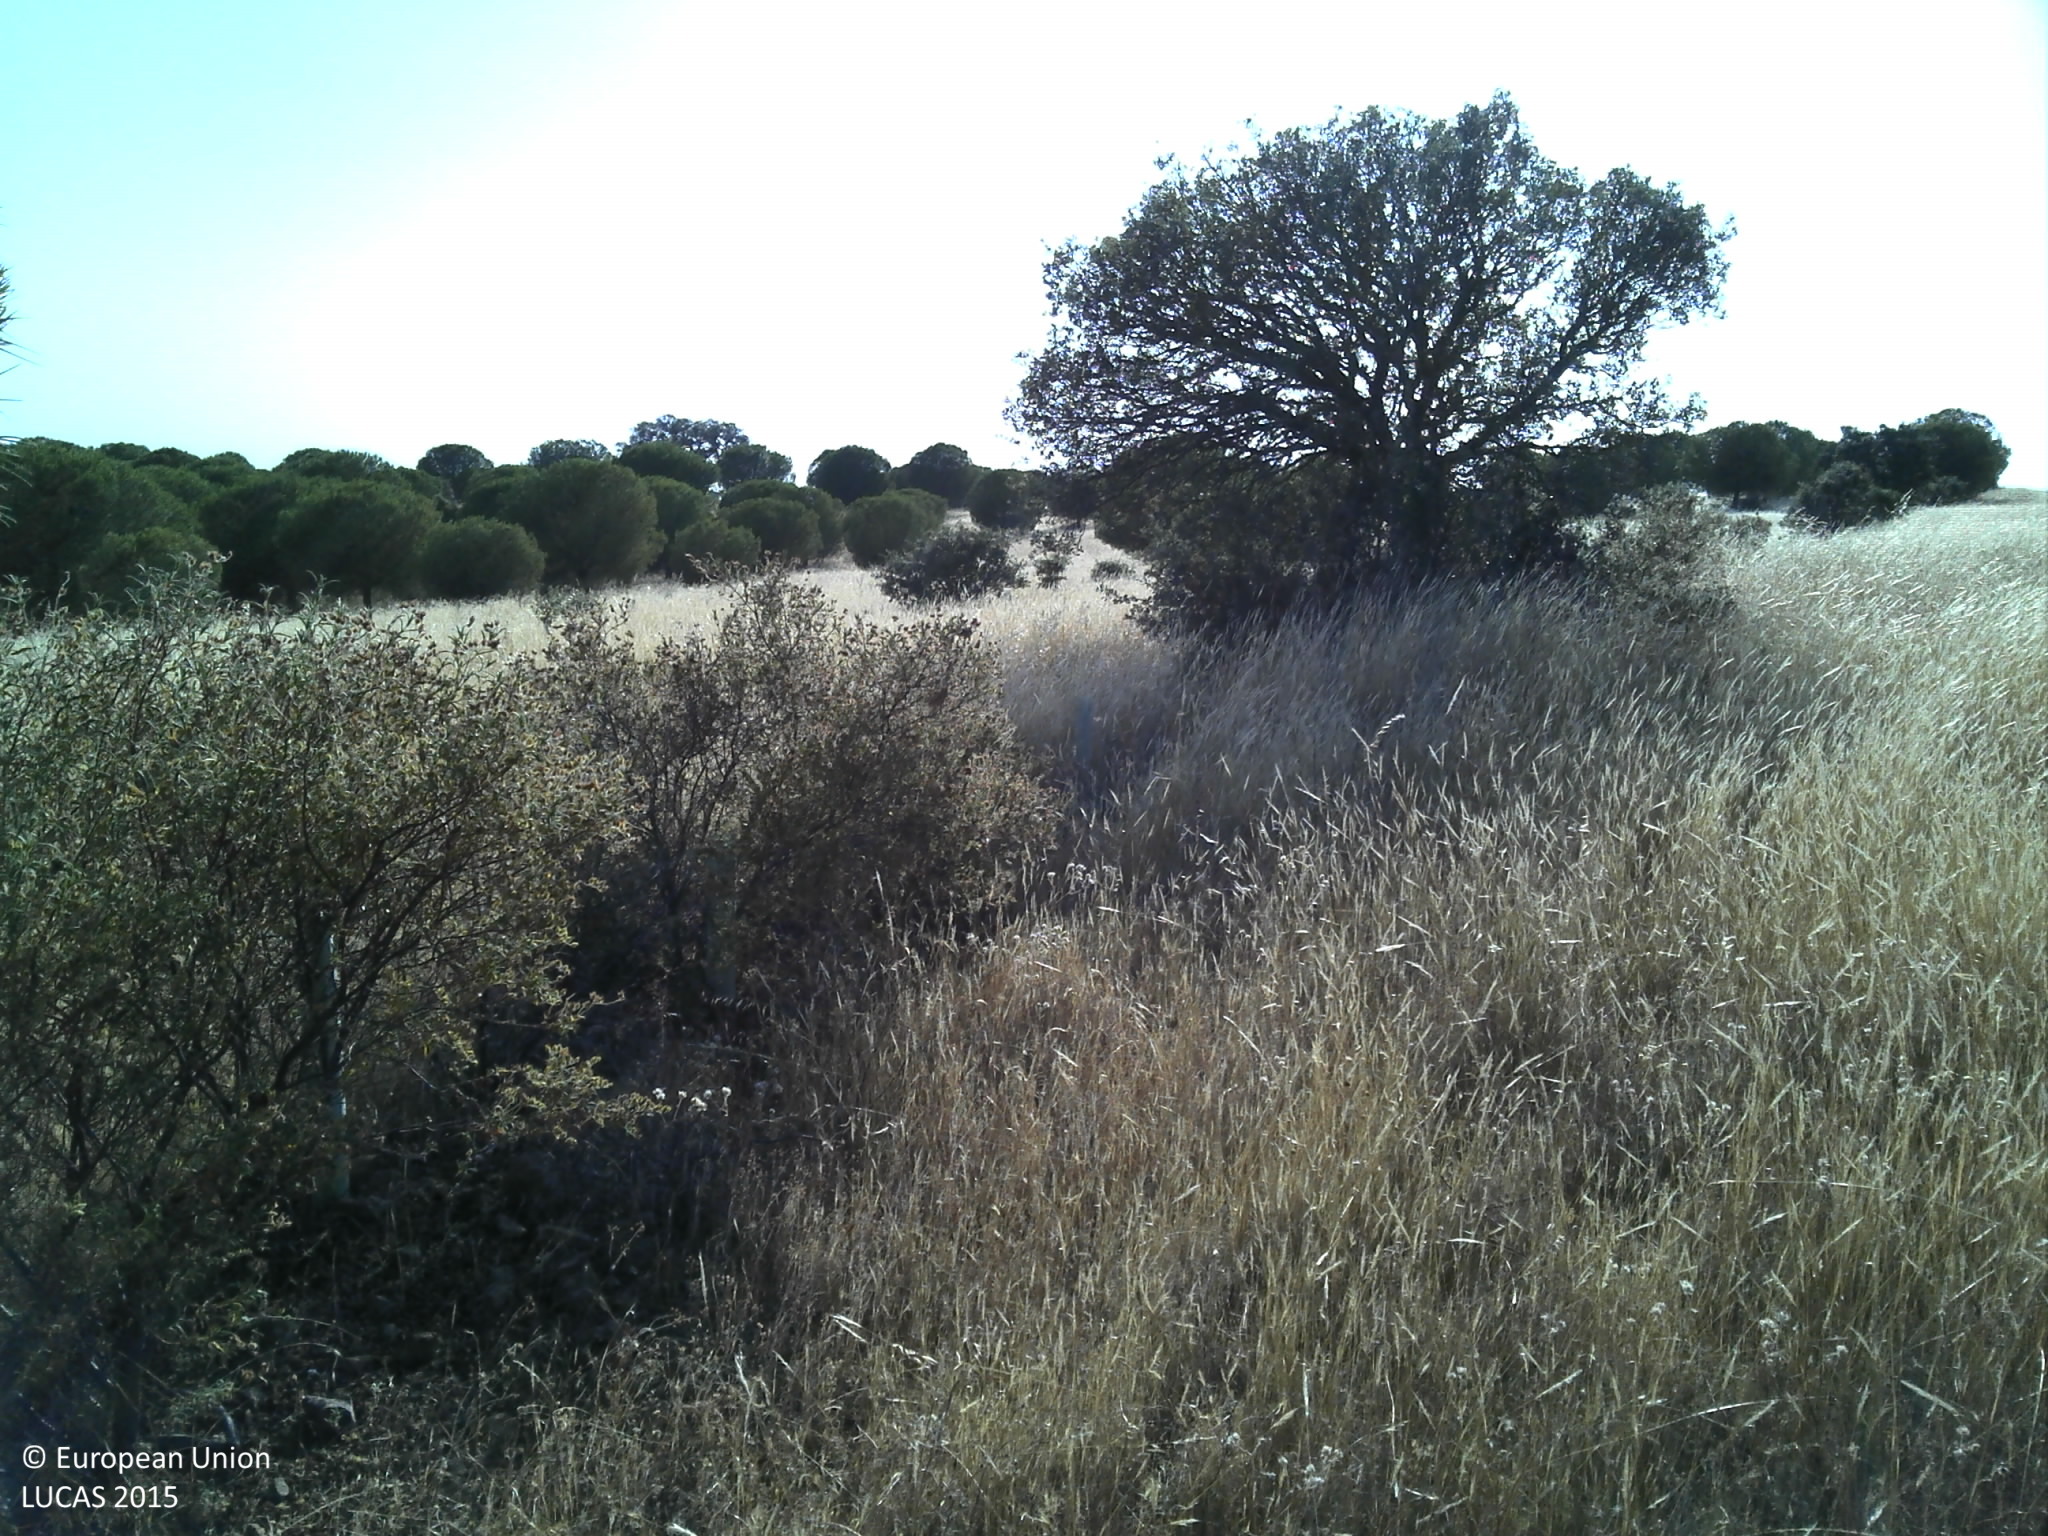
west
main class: Woodland
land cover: Pine dominated coniferous woodland
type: coniferous forest of the mediterranean region
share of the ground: 10 - 25 %
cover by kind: herbaceous plants 65 %, coniferous forest trees 25 %, broadleaved forest trees 5 %, shrubs 5 %
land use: Forestry
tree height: < 5 m
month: June
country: PT
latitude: 37.6160
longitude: -7.5617
